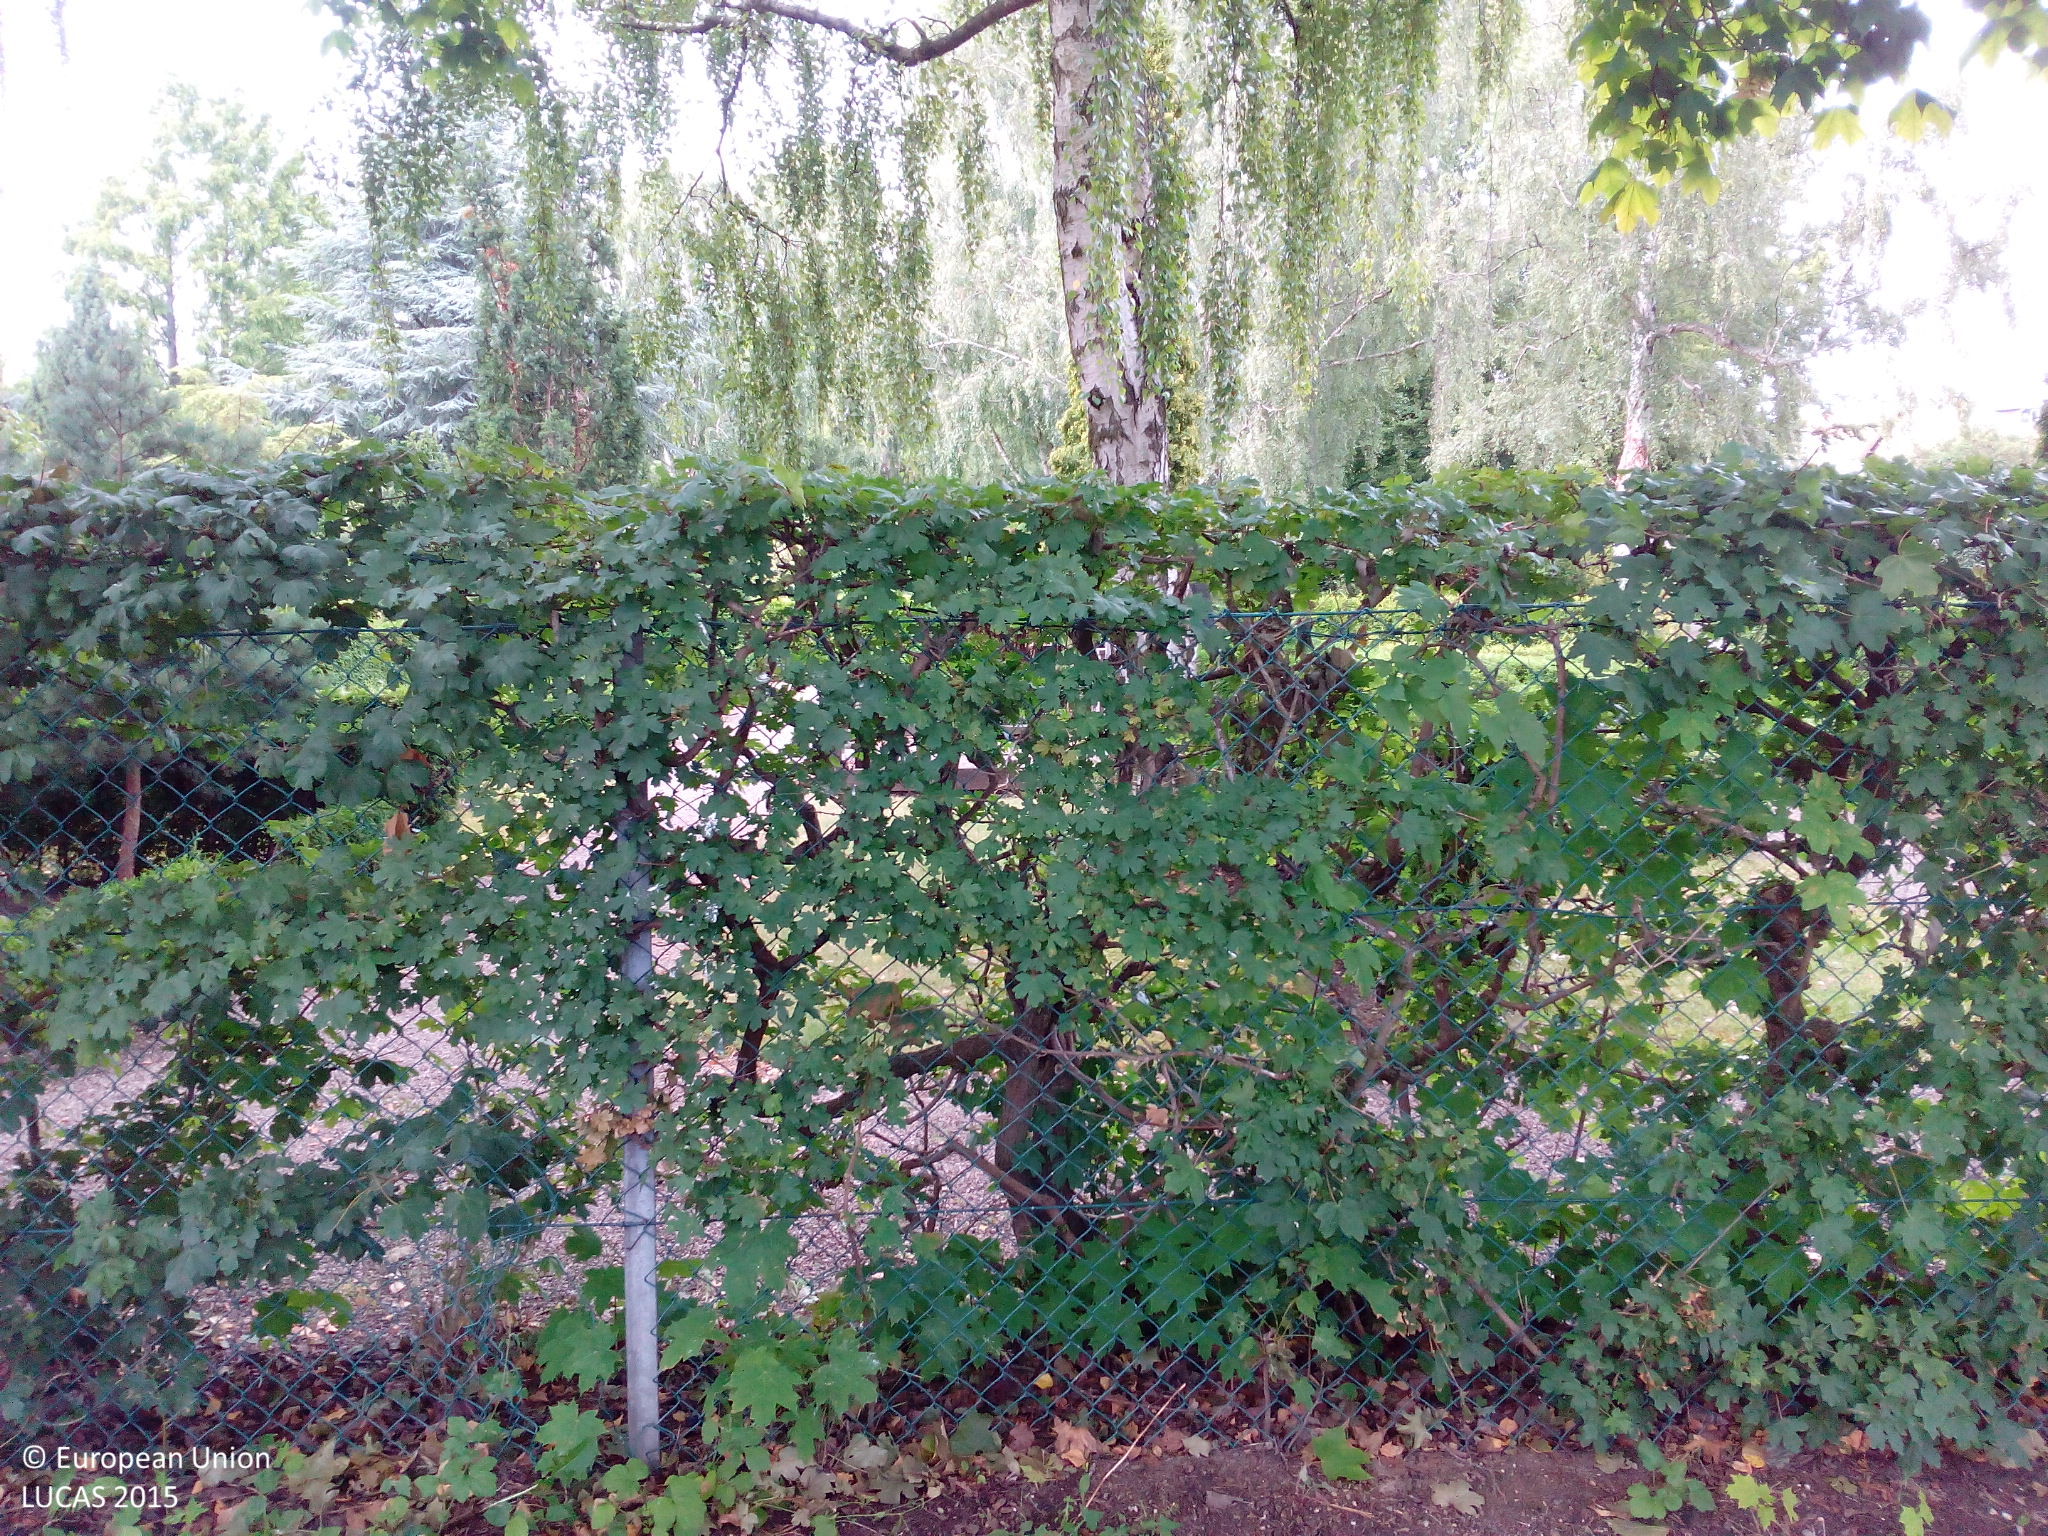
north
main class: Grassland
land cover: Grassland without tree/shrub cover
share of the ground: > 75 %
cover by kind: herbaceous plants 100 %
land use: Residential
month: July
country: DK
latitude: 55.7306
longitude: 12.5617
